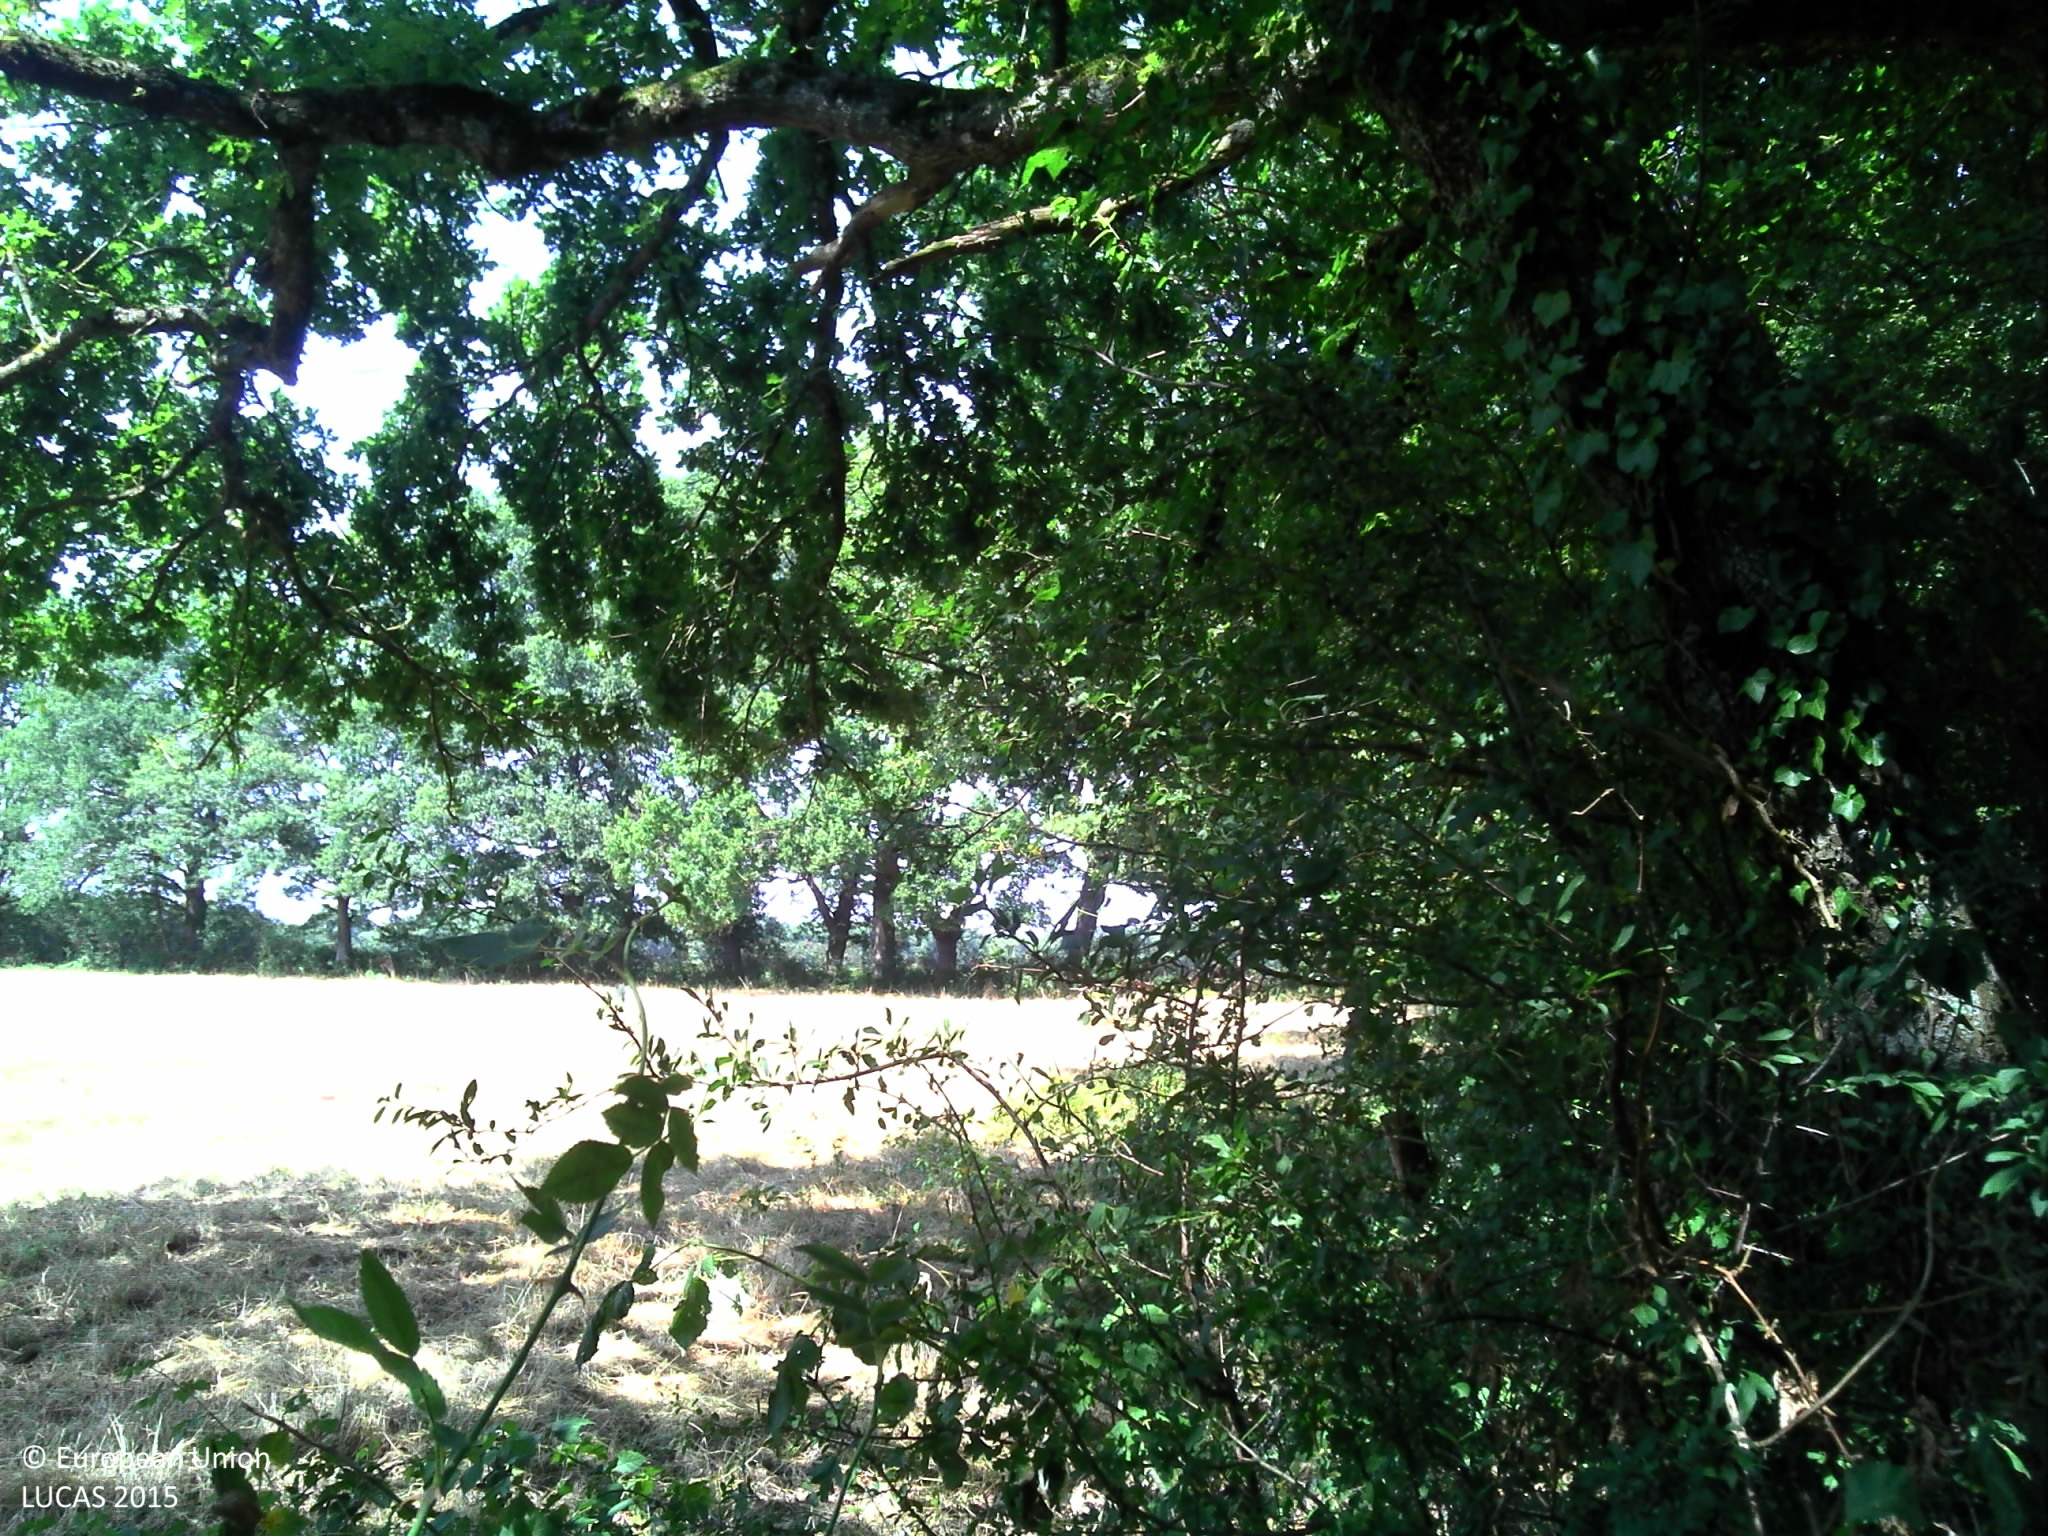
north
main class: Grassland
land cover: Grassland without tree/shrub cover
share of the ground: > 75 %
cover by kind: herbaceous plants 100 %
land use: Agriculture (excluding fallow land and kitchen gardens)
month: August
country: FR
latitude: 46.7684
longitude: 2.9380
